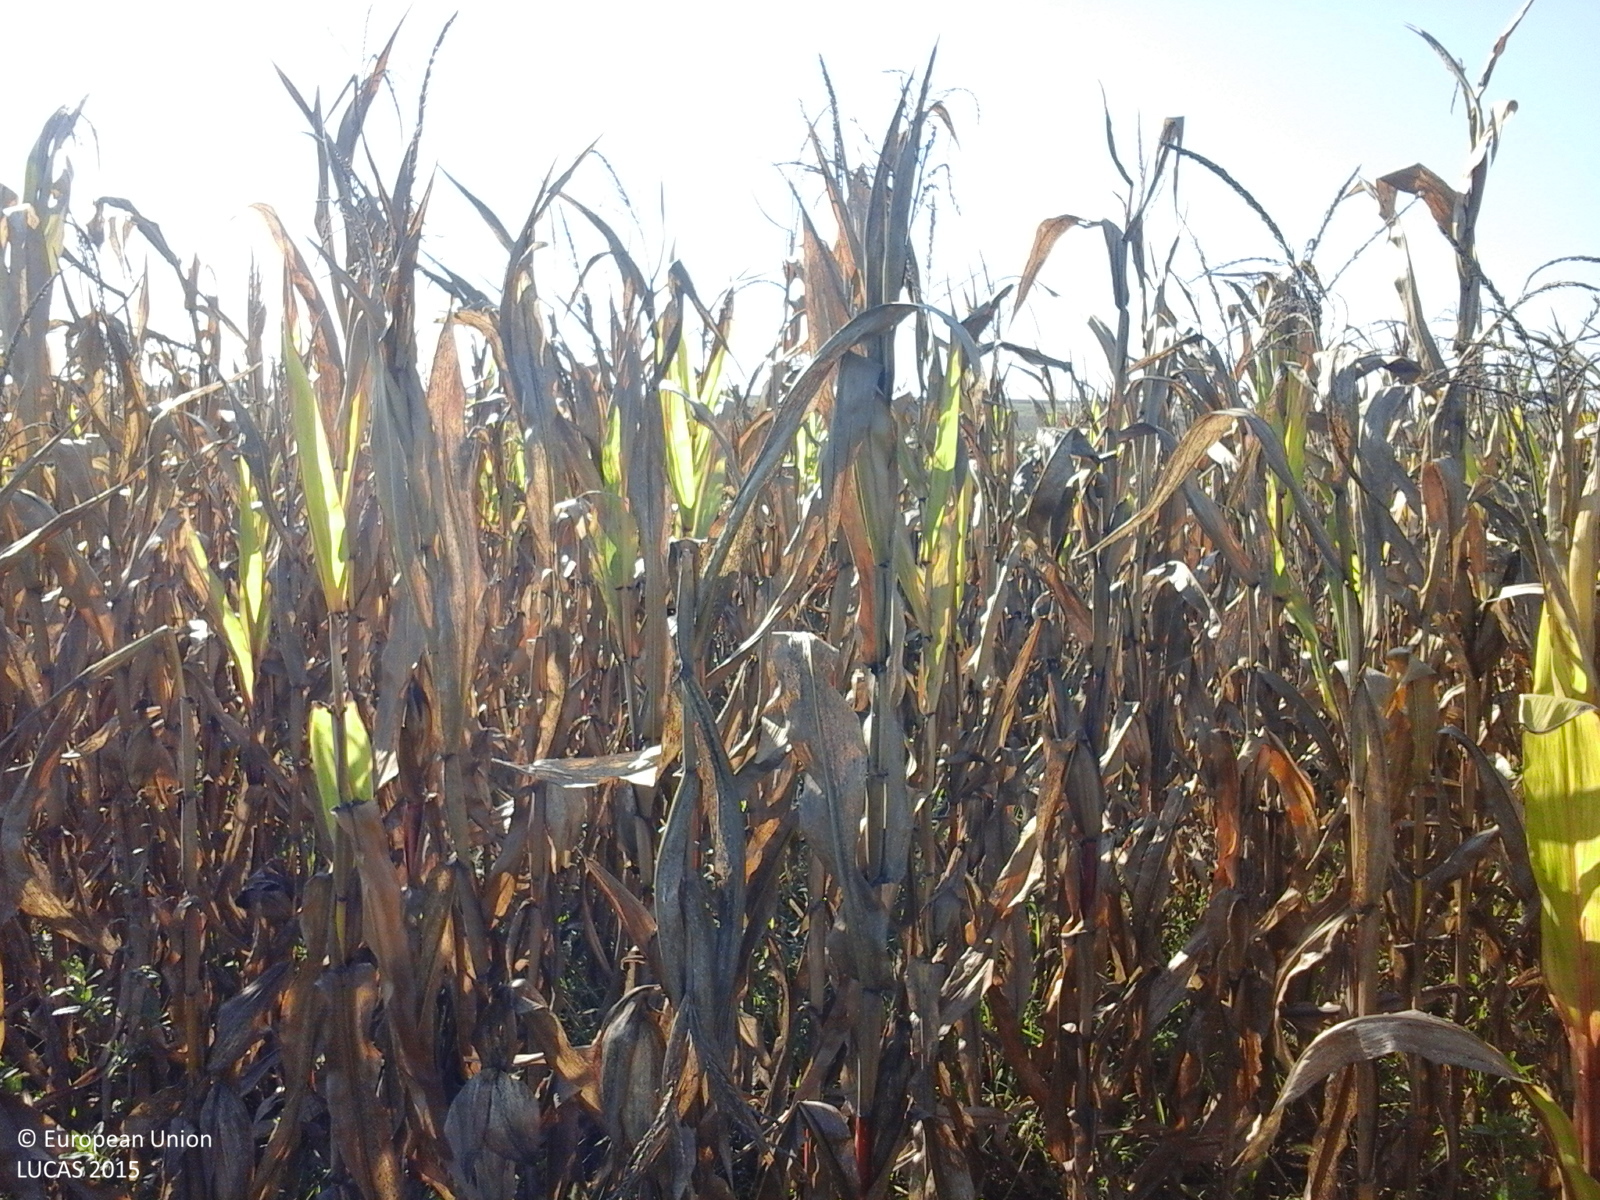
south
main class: Cropland
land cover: Lucerne
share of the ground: > 75 %
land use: Agriculture (excluding fallow land and kitchen gardens)
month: October
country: RO
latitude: 46.0673
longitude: 23.8394
